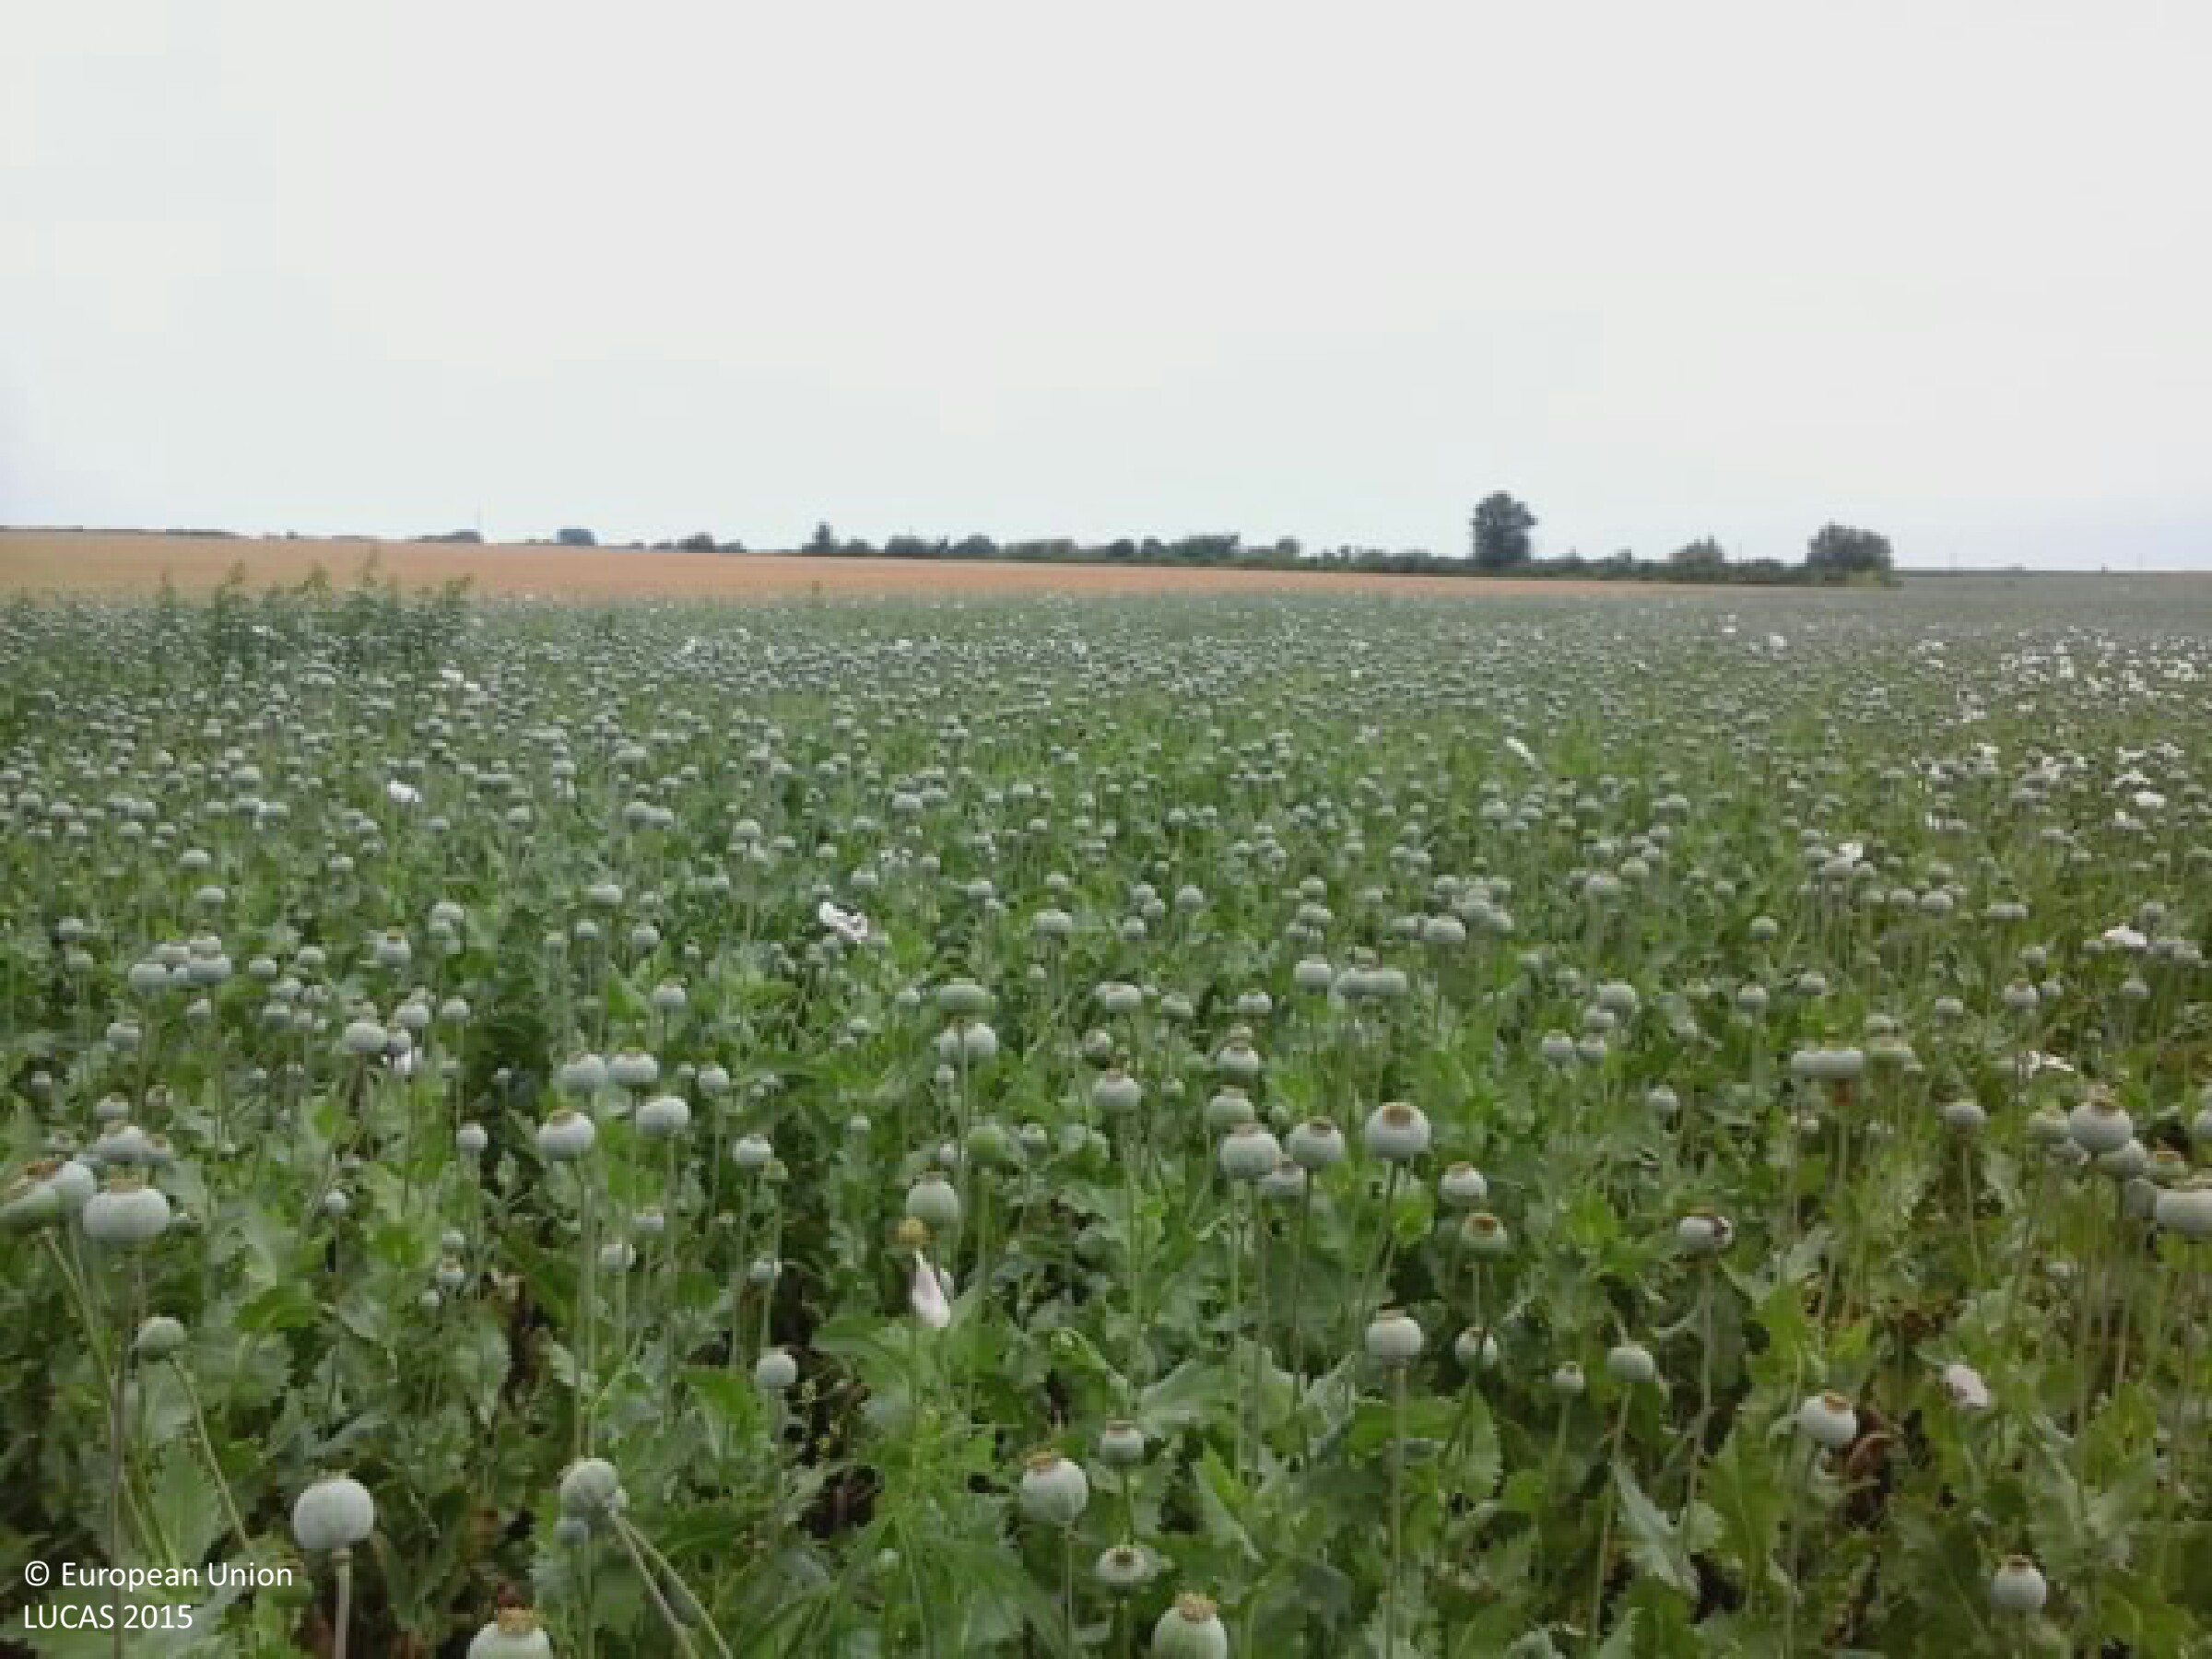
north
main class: Cropland
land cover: Other fibre and oleaginous crops
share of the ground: > 75 %
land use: Agriculture (excluding fallow land and kitchen gardens)
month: June
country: HU
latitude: 46.2141
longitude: 19.1260
